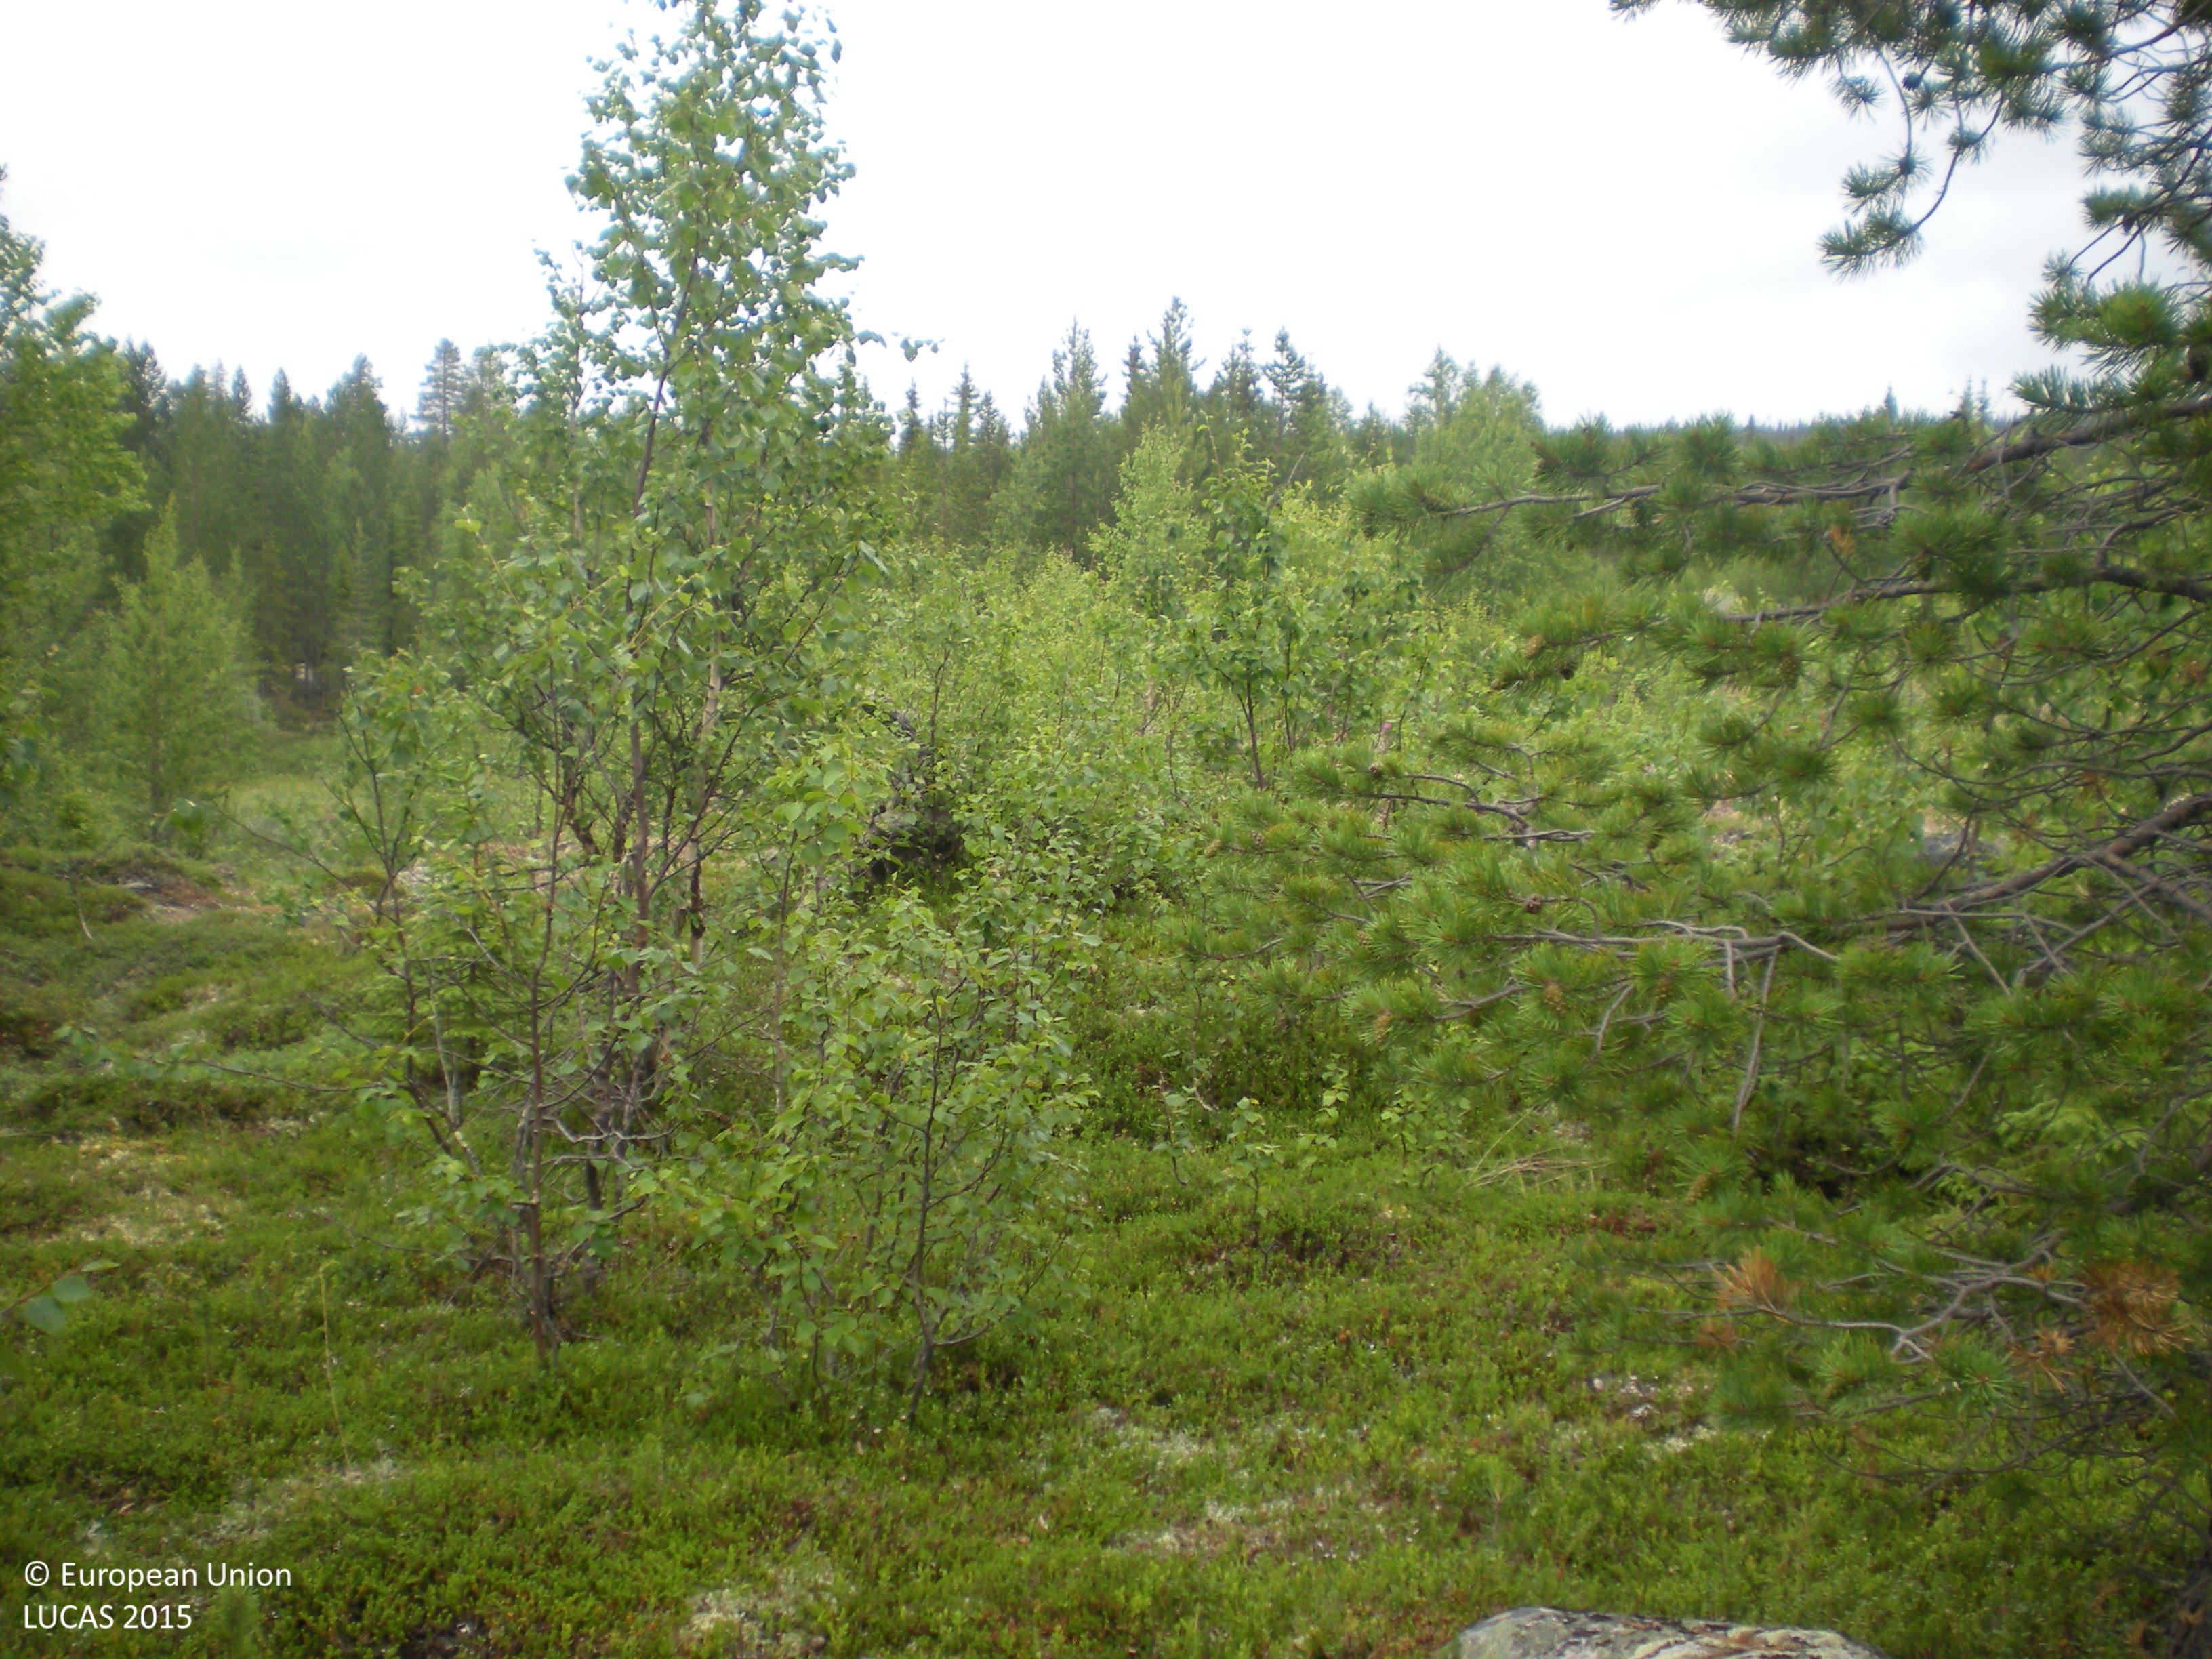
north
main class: Woodland
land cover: Pine dominated mixed woodland
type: boreal forest
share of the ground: 50 - 75 %
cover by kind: coniferous forest trees 45 %, shrubs 20 %, broadleaved forest trees 15 %, lichens and mosses 10 %, consolidated bare surface 10 %
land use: Forestry
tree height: > 5 m
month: August
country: SE
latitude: 66.2134
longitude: 18.0192
